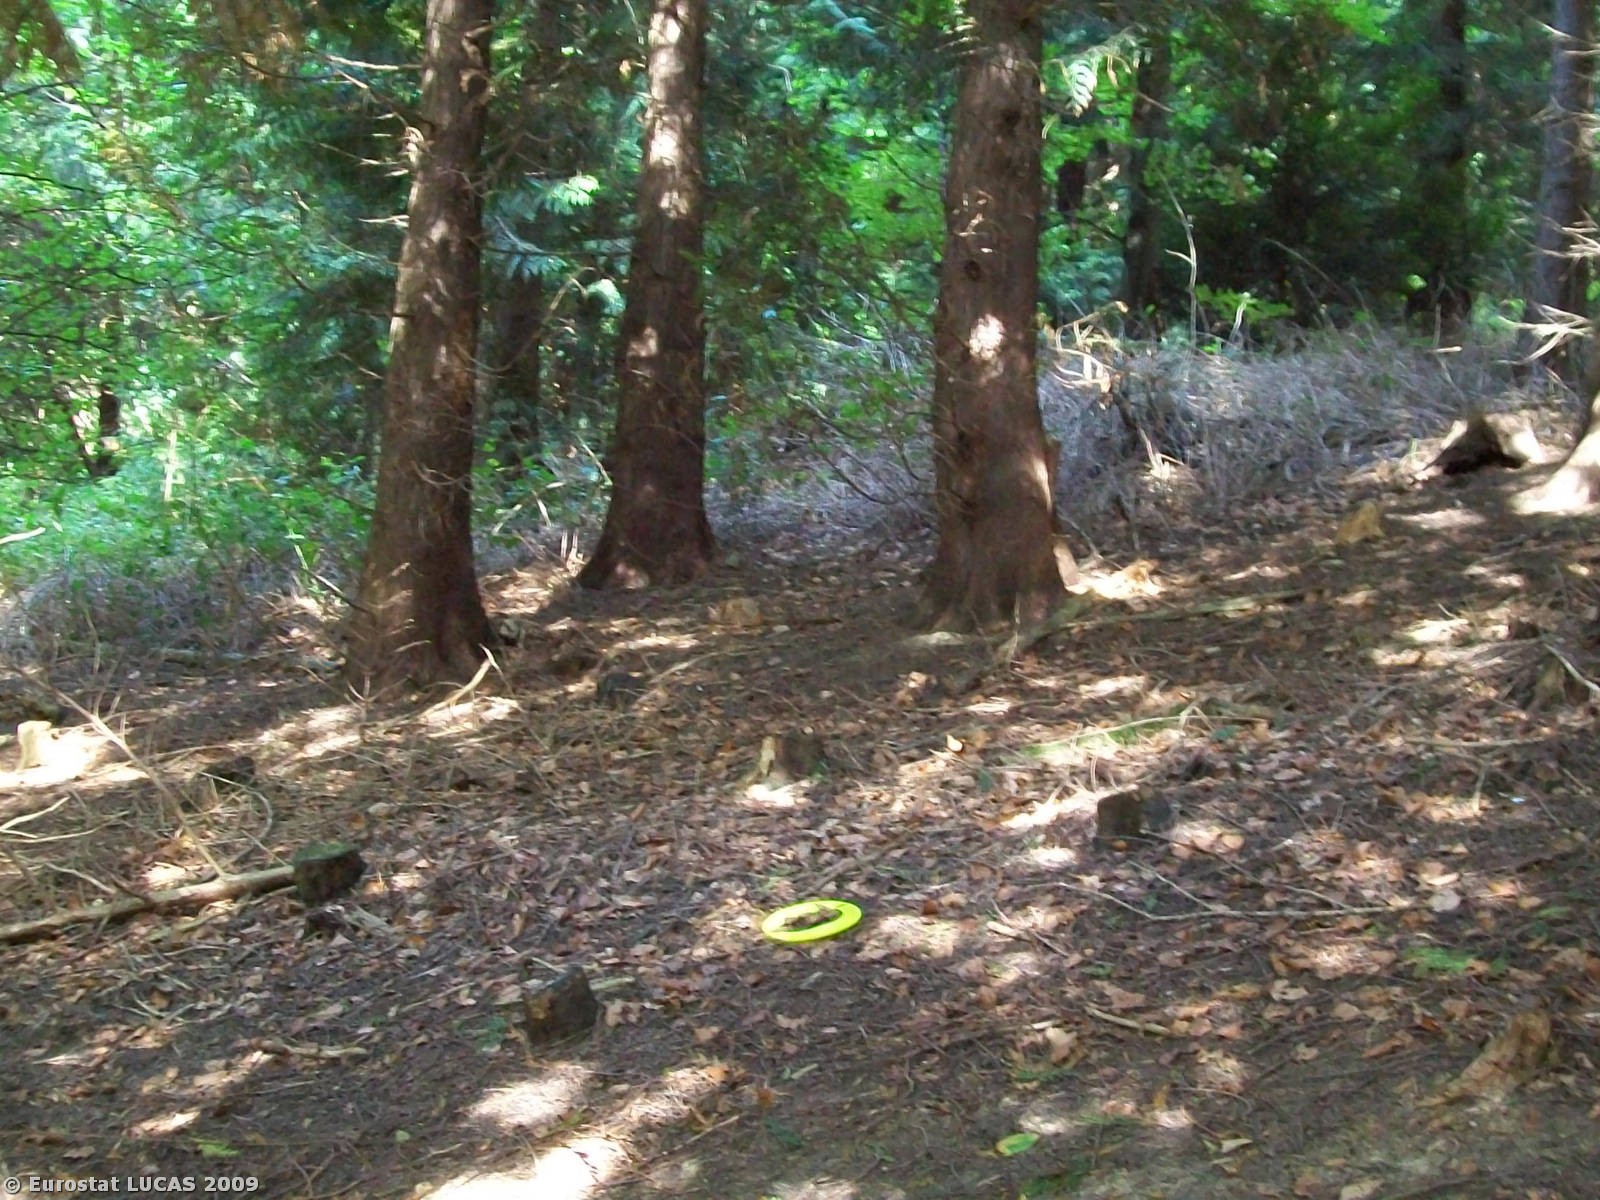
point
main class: Woodland
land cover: Coniferous woodland
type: plantations and self-sown exotic forest
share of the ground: > 75 %
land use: Community services
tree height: > 5 m
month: September
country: GB
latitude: 52.0324
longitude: -2.4112
